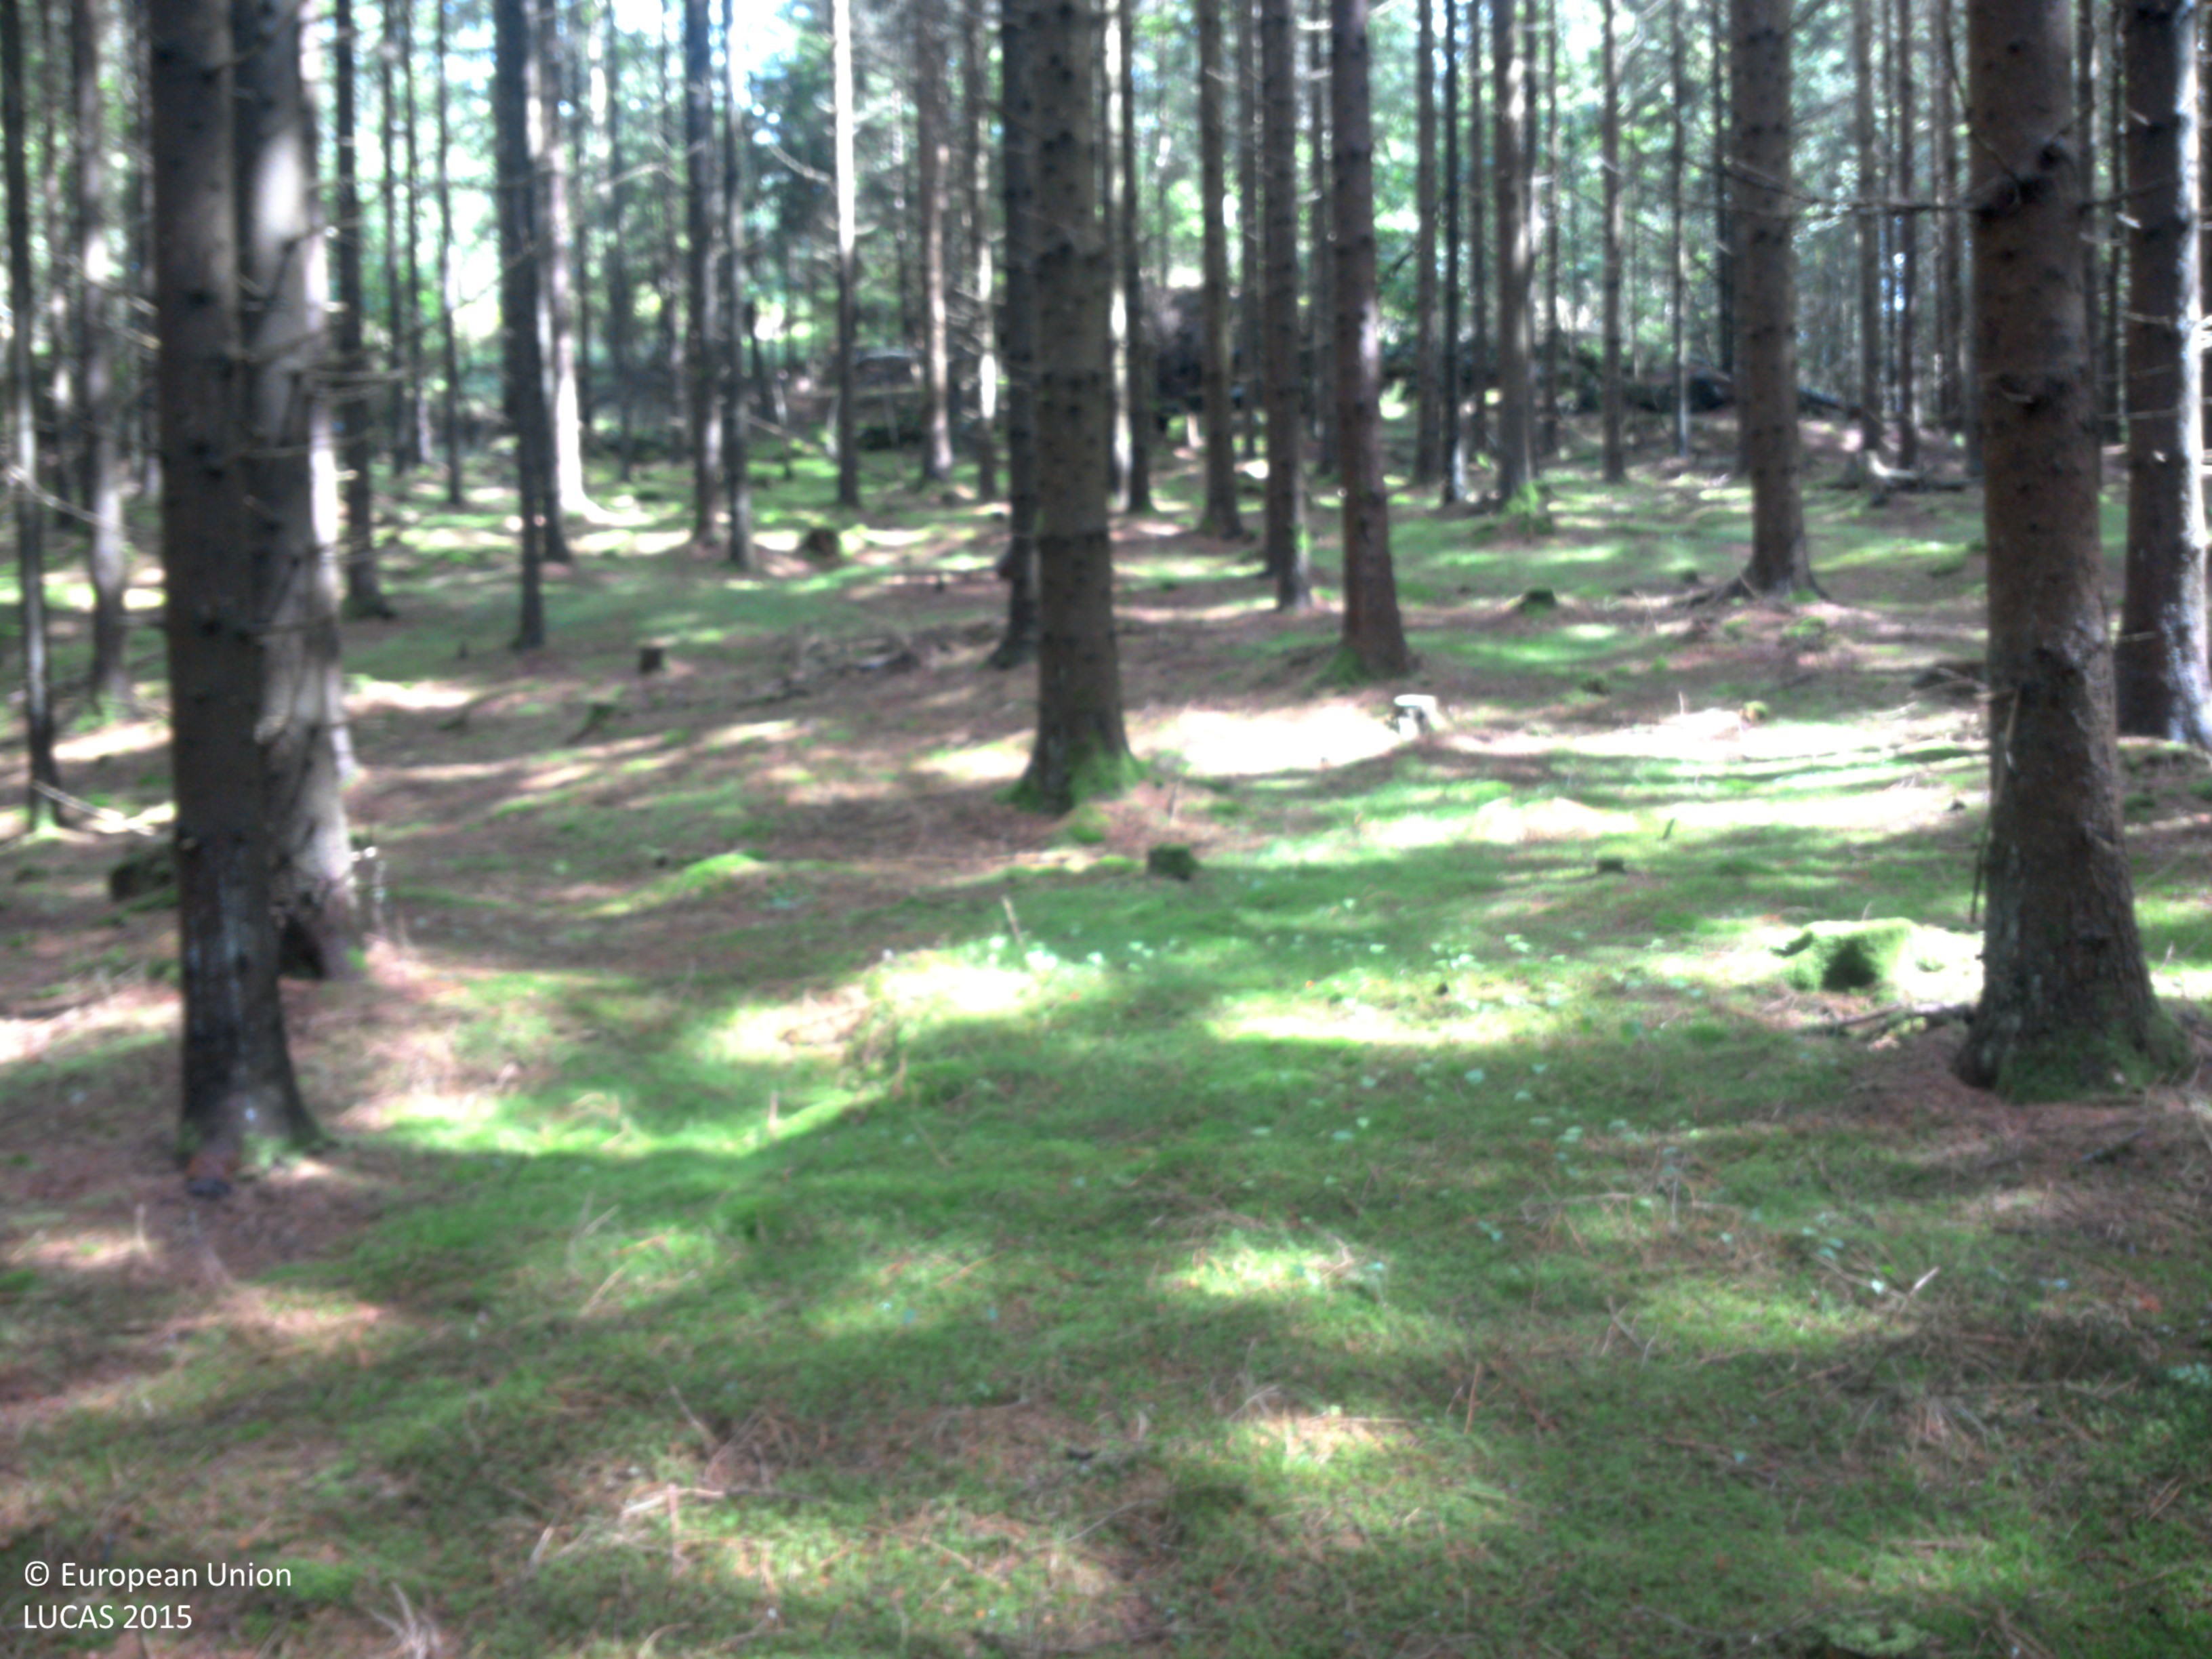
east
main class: Woodland
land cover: Spruce dominated coniferous woodland
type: boreal forest
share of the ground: 50 - 75 %
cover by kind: coniferous forest trees 75 %, lichens and mosses 25 %
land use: Forestry
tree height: > 5 m
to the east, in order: Spruce dominated coniferous woodland; Dry stone walls; Spruce dominated mixed woodland; Spruce dominated coniferous woodland; Dry stone walls; Fences; Spruce dominated coniferous woodland; Tracks; Grassland without tree/shrub cover; Spruce dominated mixed woodland; Spruce dominated coniferous woodland; Fences; Spruce dominated coniferous woodland; Dry stone walls; Spruce dominated coniferous woodland
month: July
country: SE
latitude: 58.0969
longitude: 11.9812
